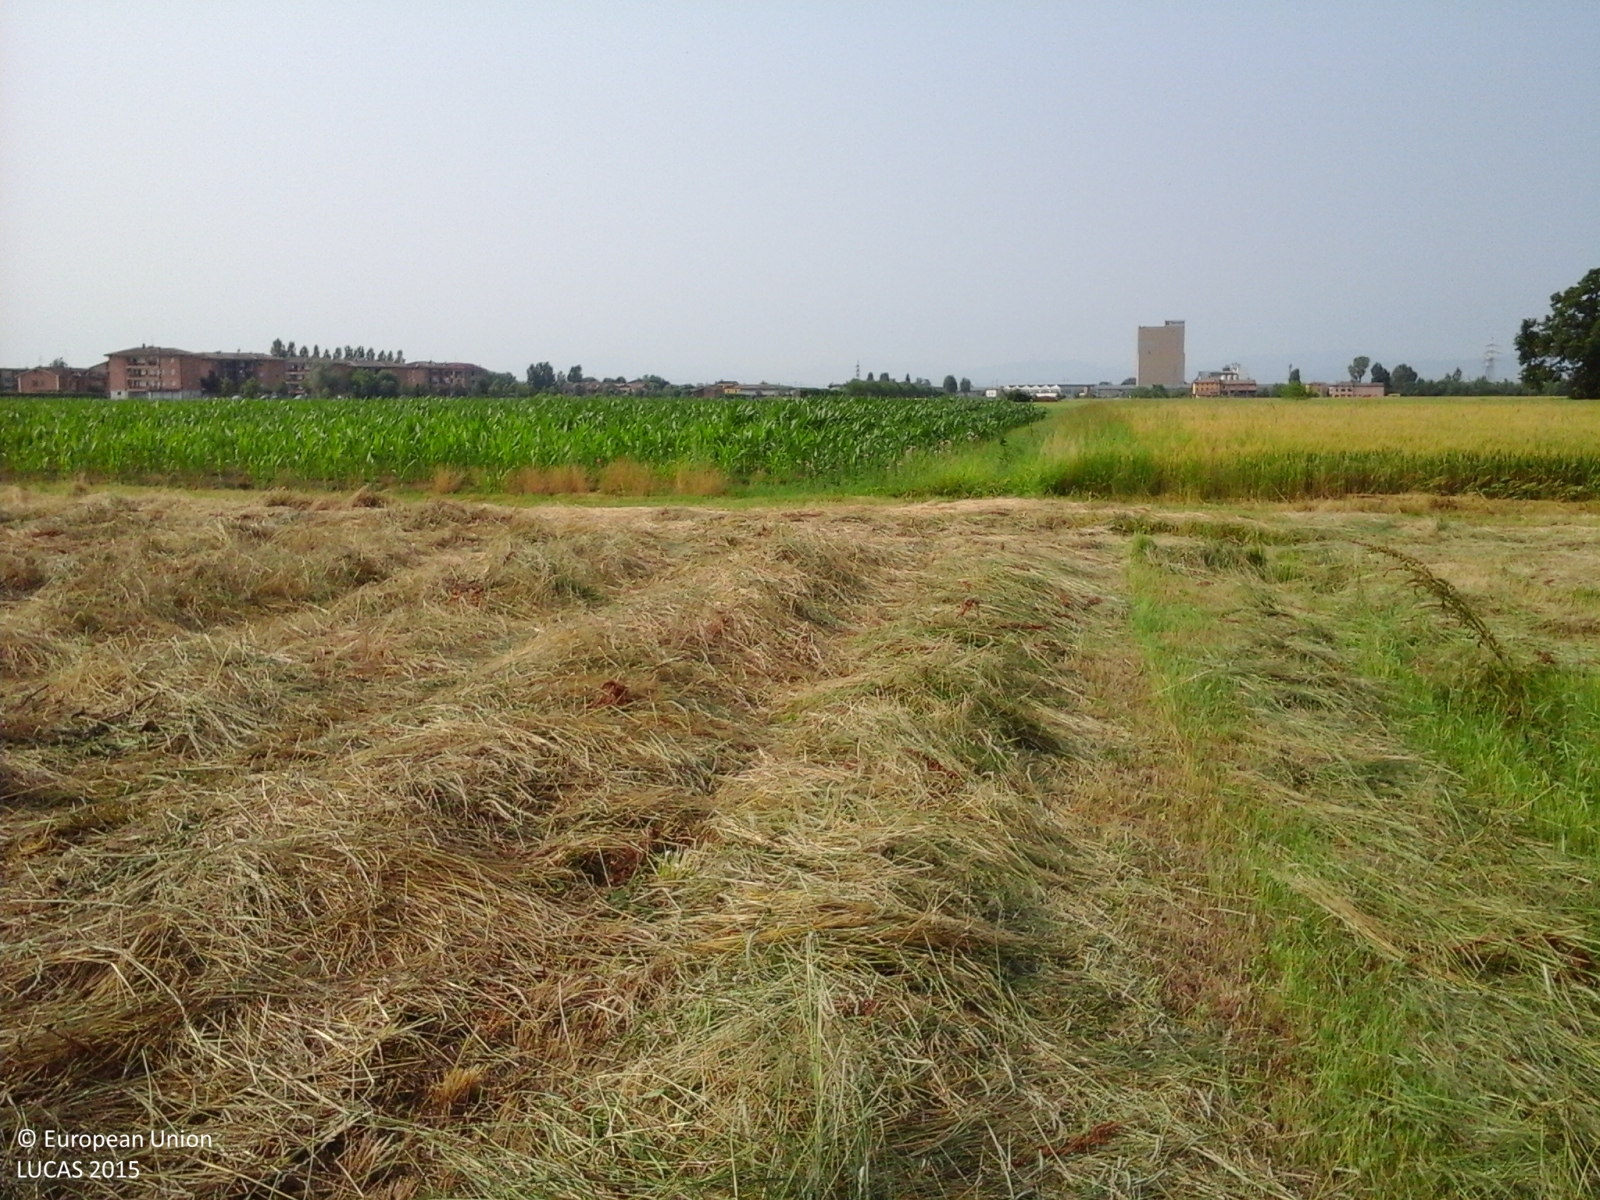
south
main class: Cropland
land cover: Temporary grasslands
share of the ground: > 75 %
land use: Agriculture (excluding fallow land and kitchen gardens)
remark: Clear cut
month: June
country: IT
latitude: 44.8367
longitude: 10.3913
